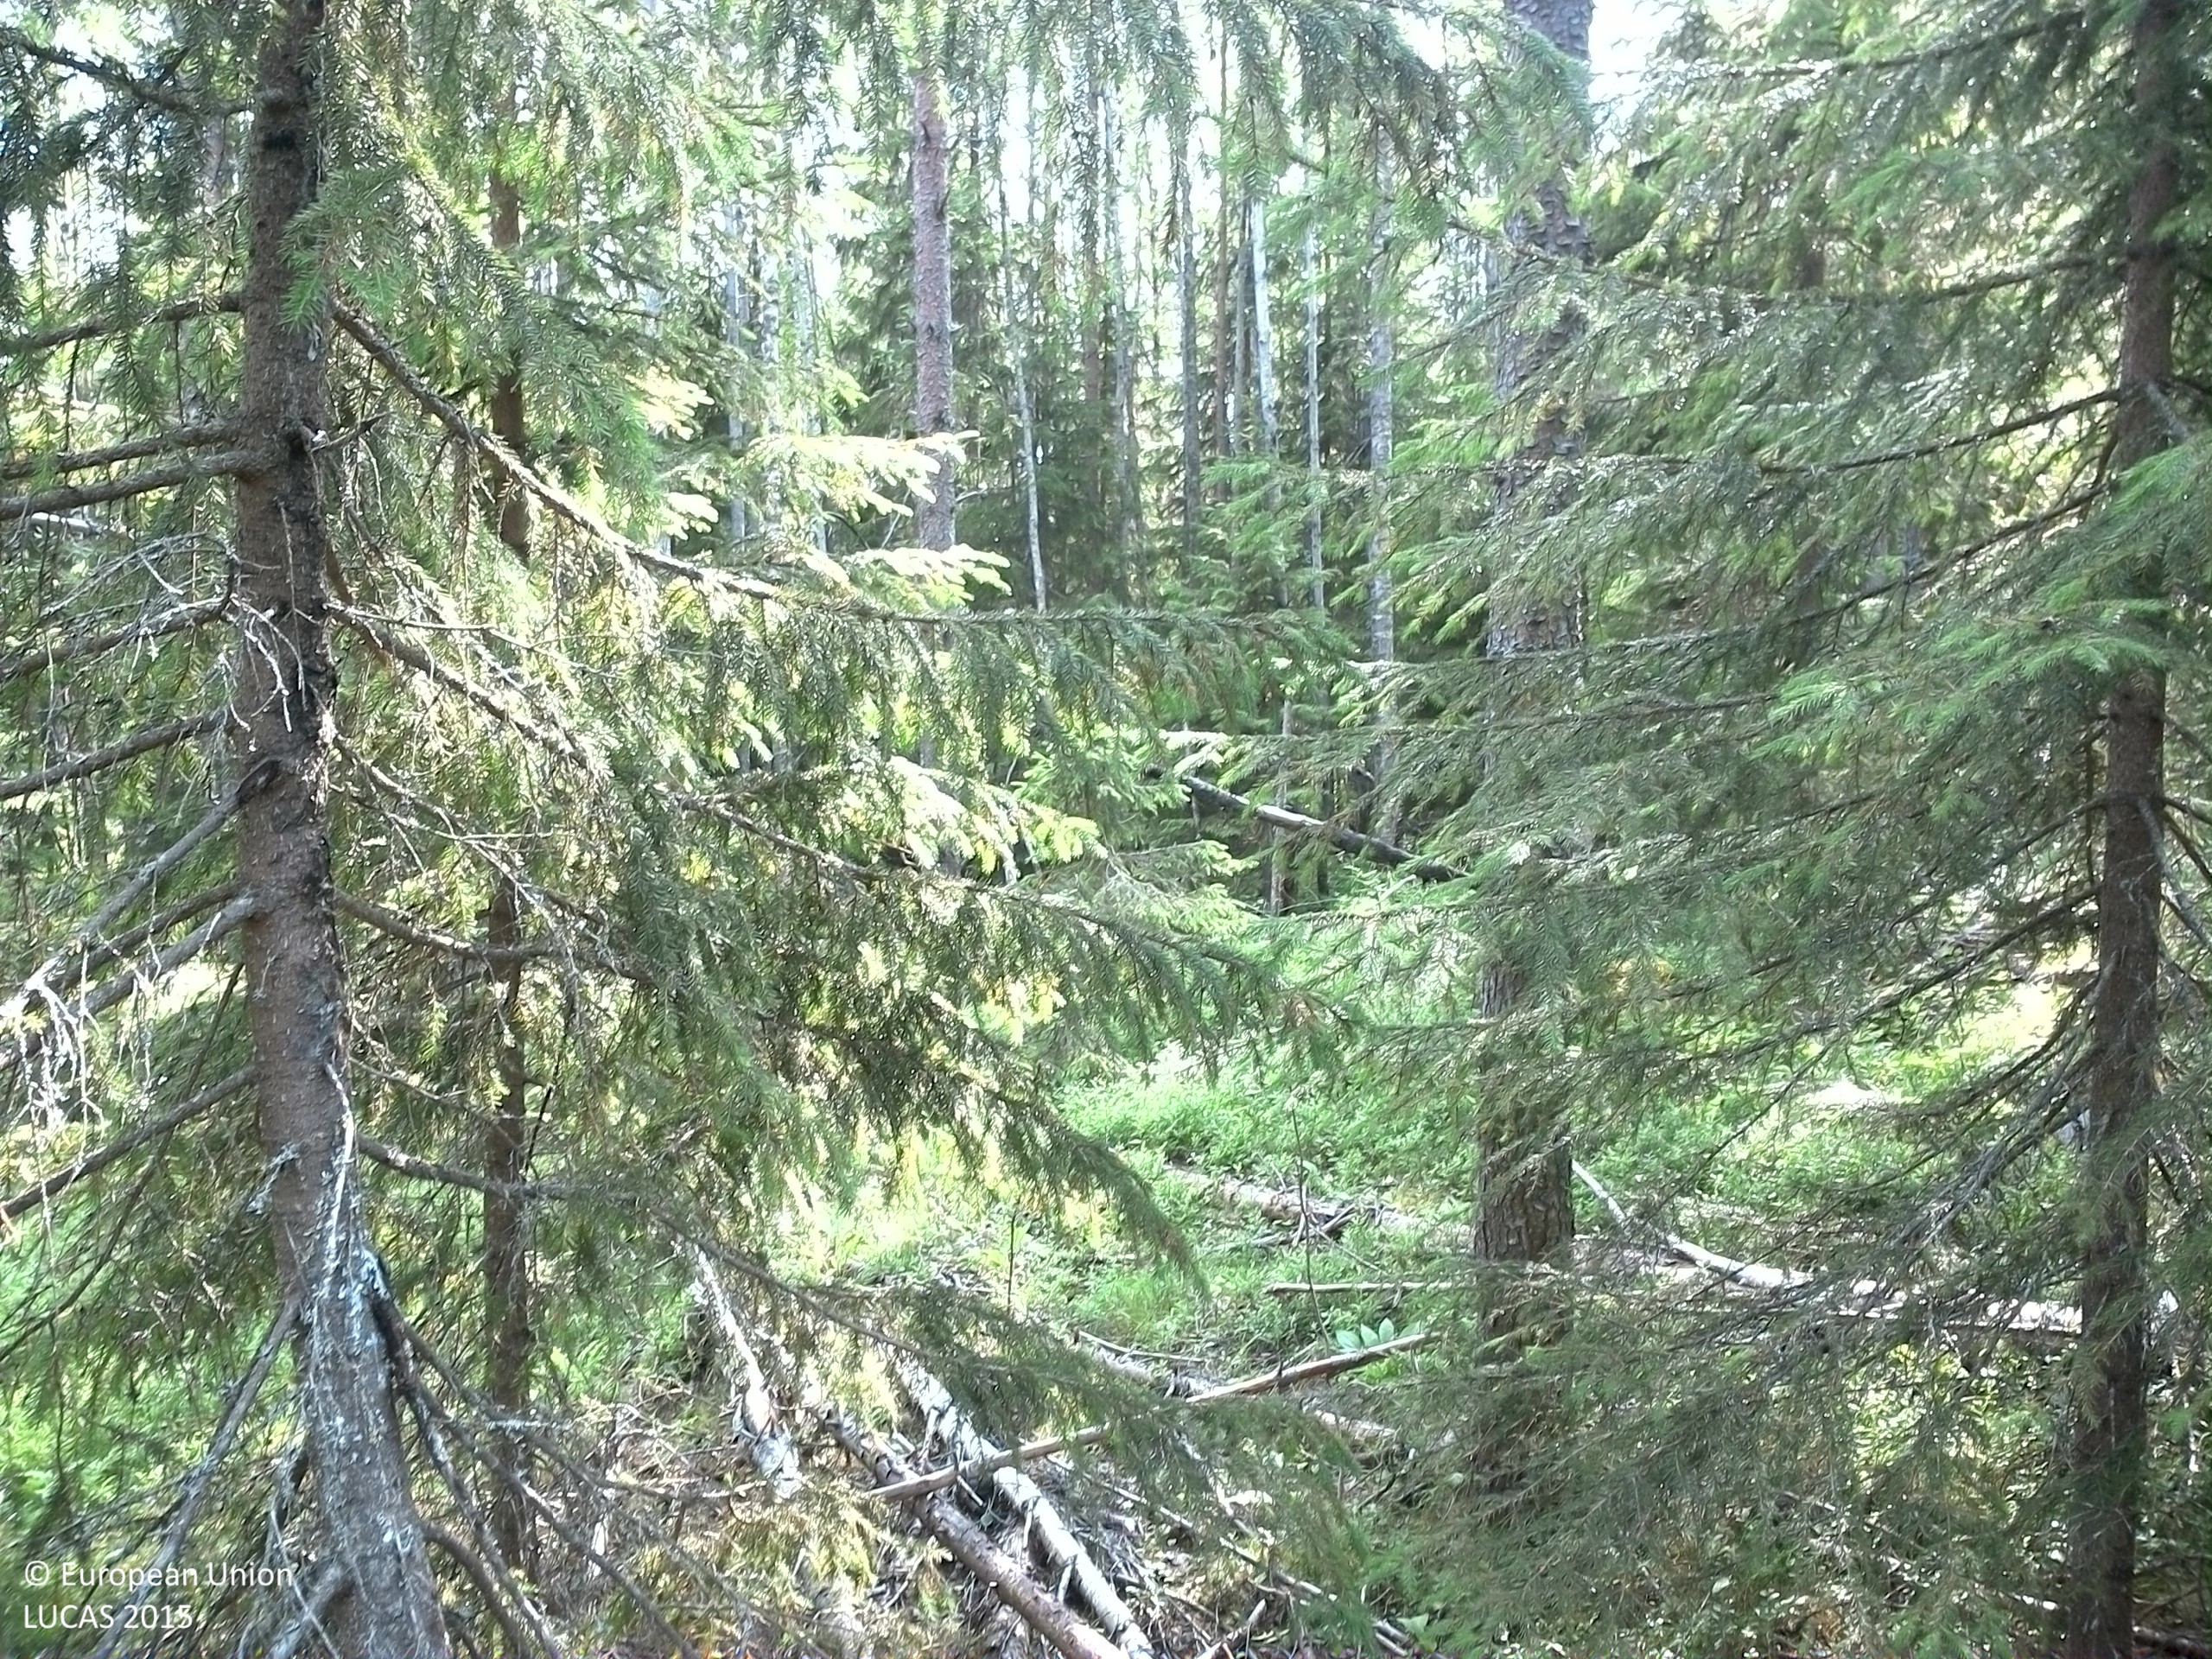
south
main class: Woodland
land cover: Pine dominated coniferous woodland
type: boreal forest
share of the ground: 50 - 75 %
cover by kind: coniferous forest trees 55 %, herbaceous plants 20 %, shrubs 10 %, lichens and mosses 10 %, broadleaved forest trees 5 %
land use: Forestry
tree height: > 5 m
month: July
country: SE
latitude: 63.5043
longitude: 17.3069
